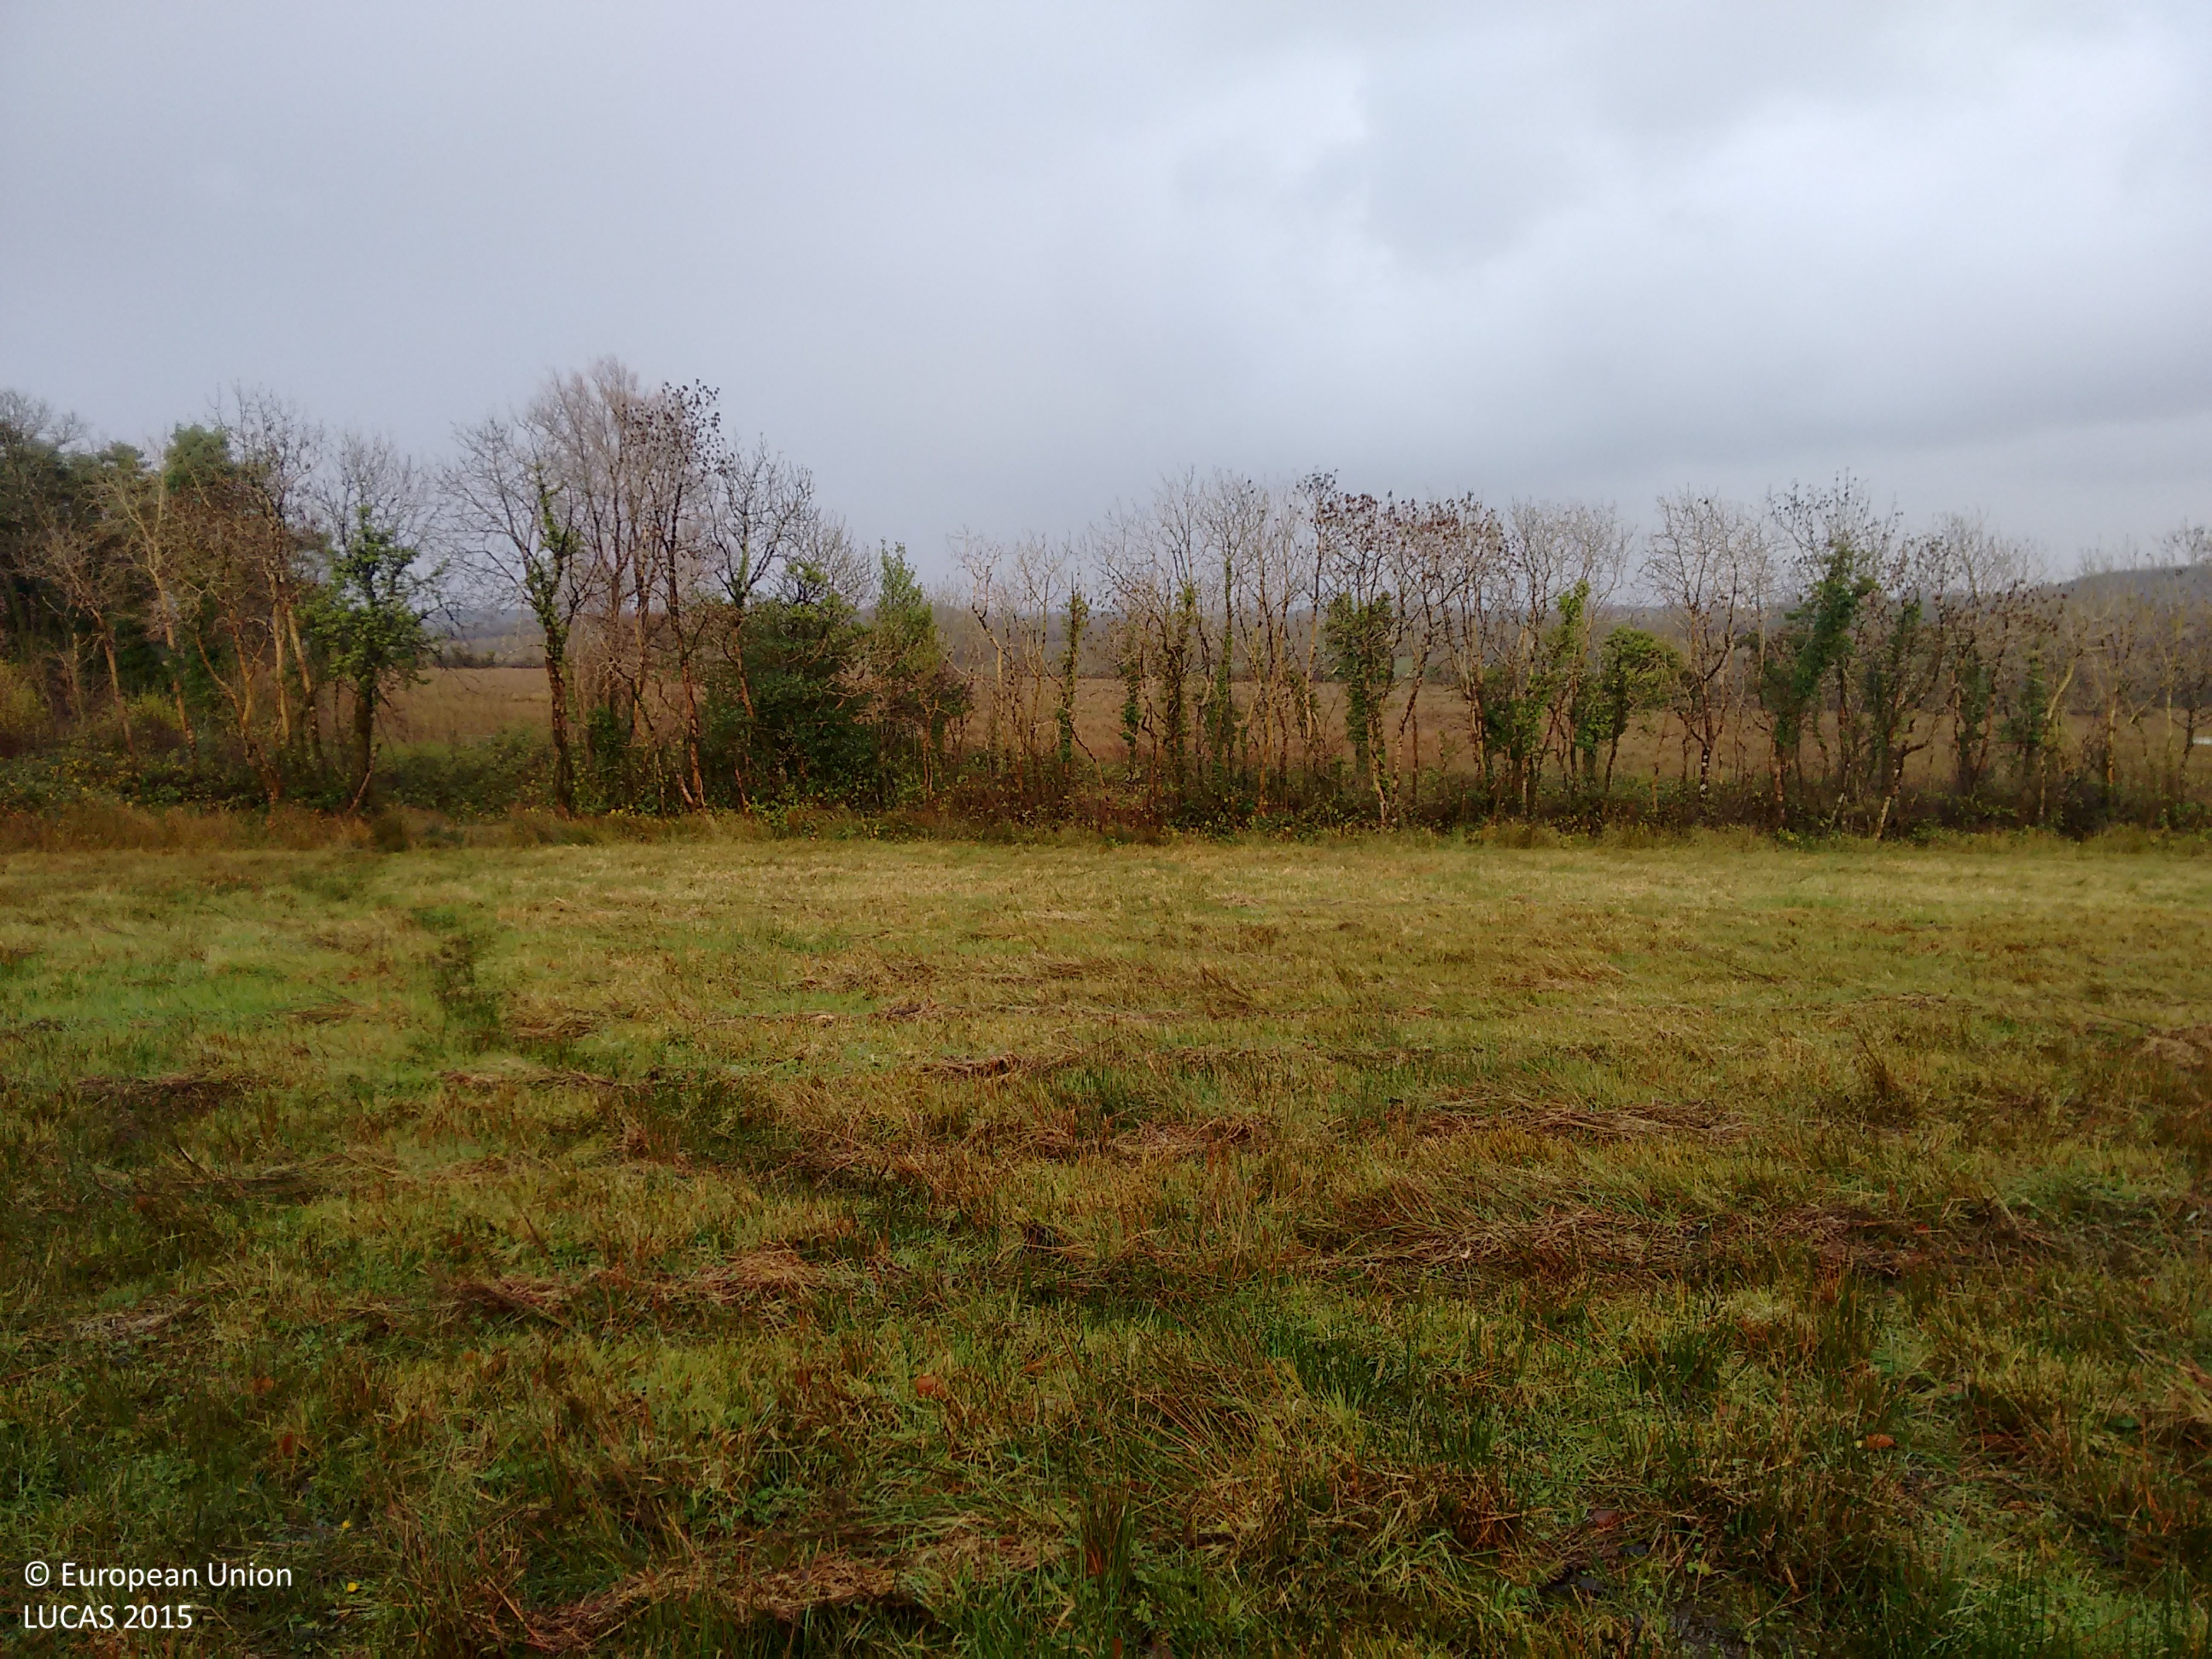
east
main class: Grassland
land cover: Grassland without tree/shrub cover
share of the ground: > 75 %
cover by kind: herbaceous plants 95 %, unconsolidated bare surface 5 %
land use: Agriculture (excluding fallow land and kitchen gardens)
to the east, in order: Grassland without tree/shrub cover; Ditches and canals; Abandoned hedges; Grassland without tree/shrub cover; Ditches and canals; Abandoned hedges; Fences; Grassland without tree/shrub cover
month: November
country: IE
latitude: 53.9486
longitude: -8.0489
